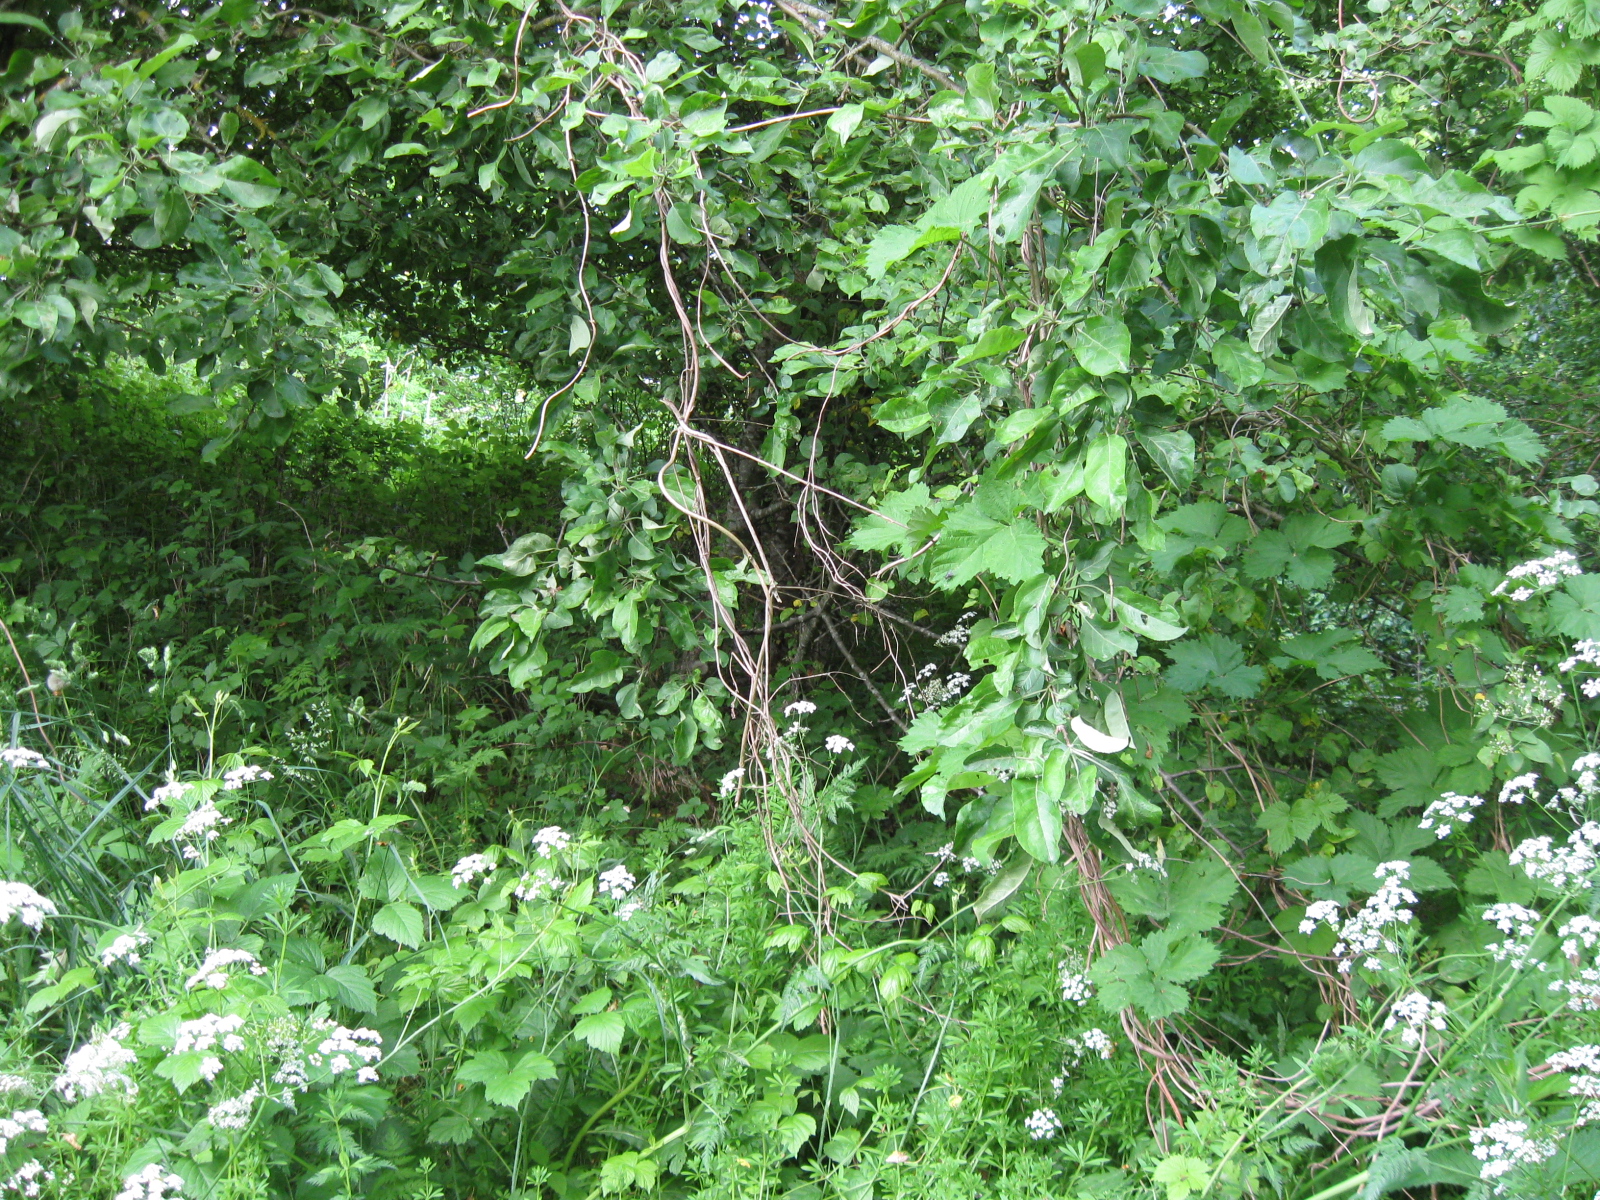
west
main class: Woodland
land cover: Broadleaved woodland
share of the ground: 50 - 75 %
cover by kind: broadleaved forest trees 65 %, herbaceous plants 35 %
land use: Semi-natural and natural areas not in use
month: June
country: LT
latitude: 54.5496
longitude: 23.8957
